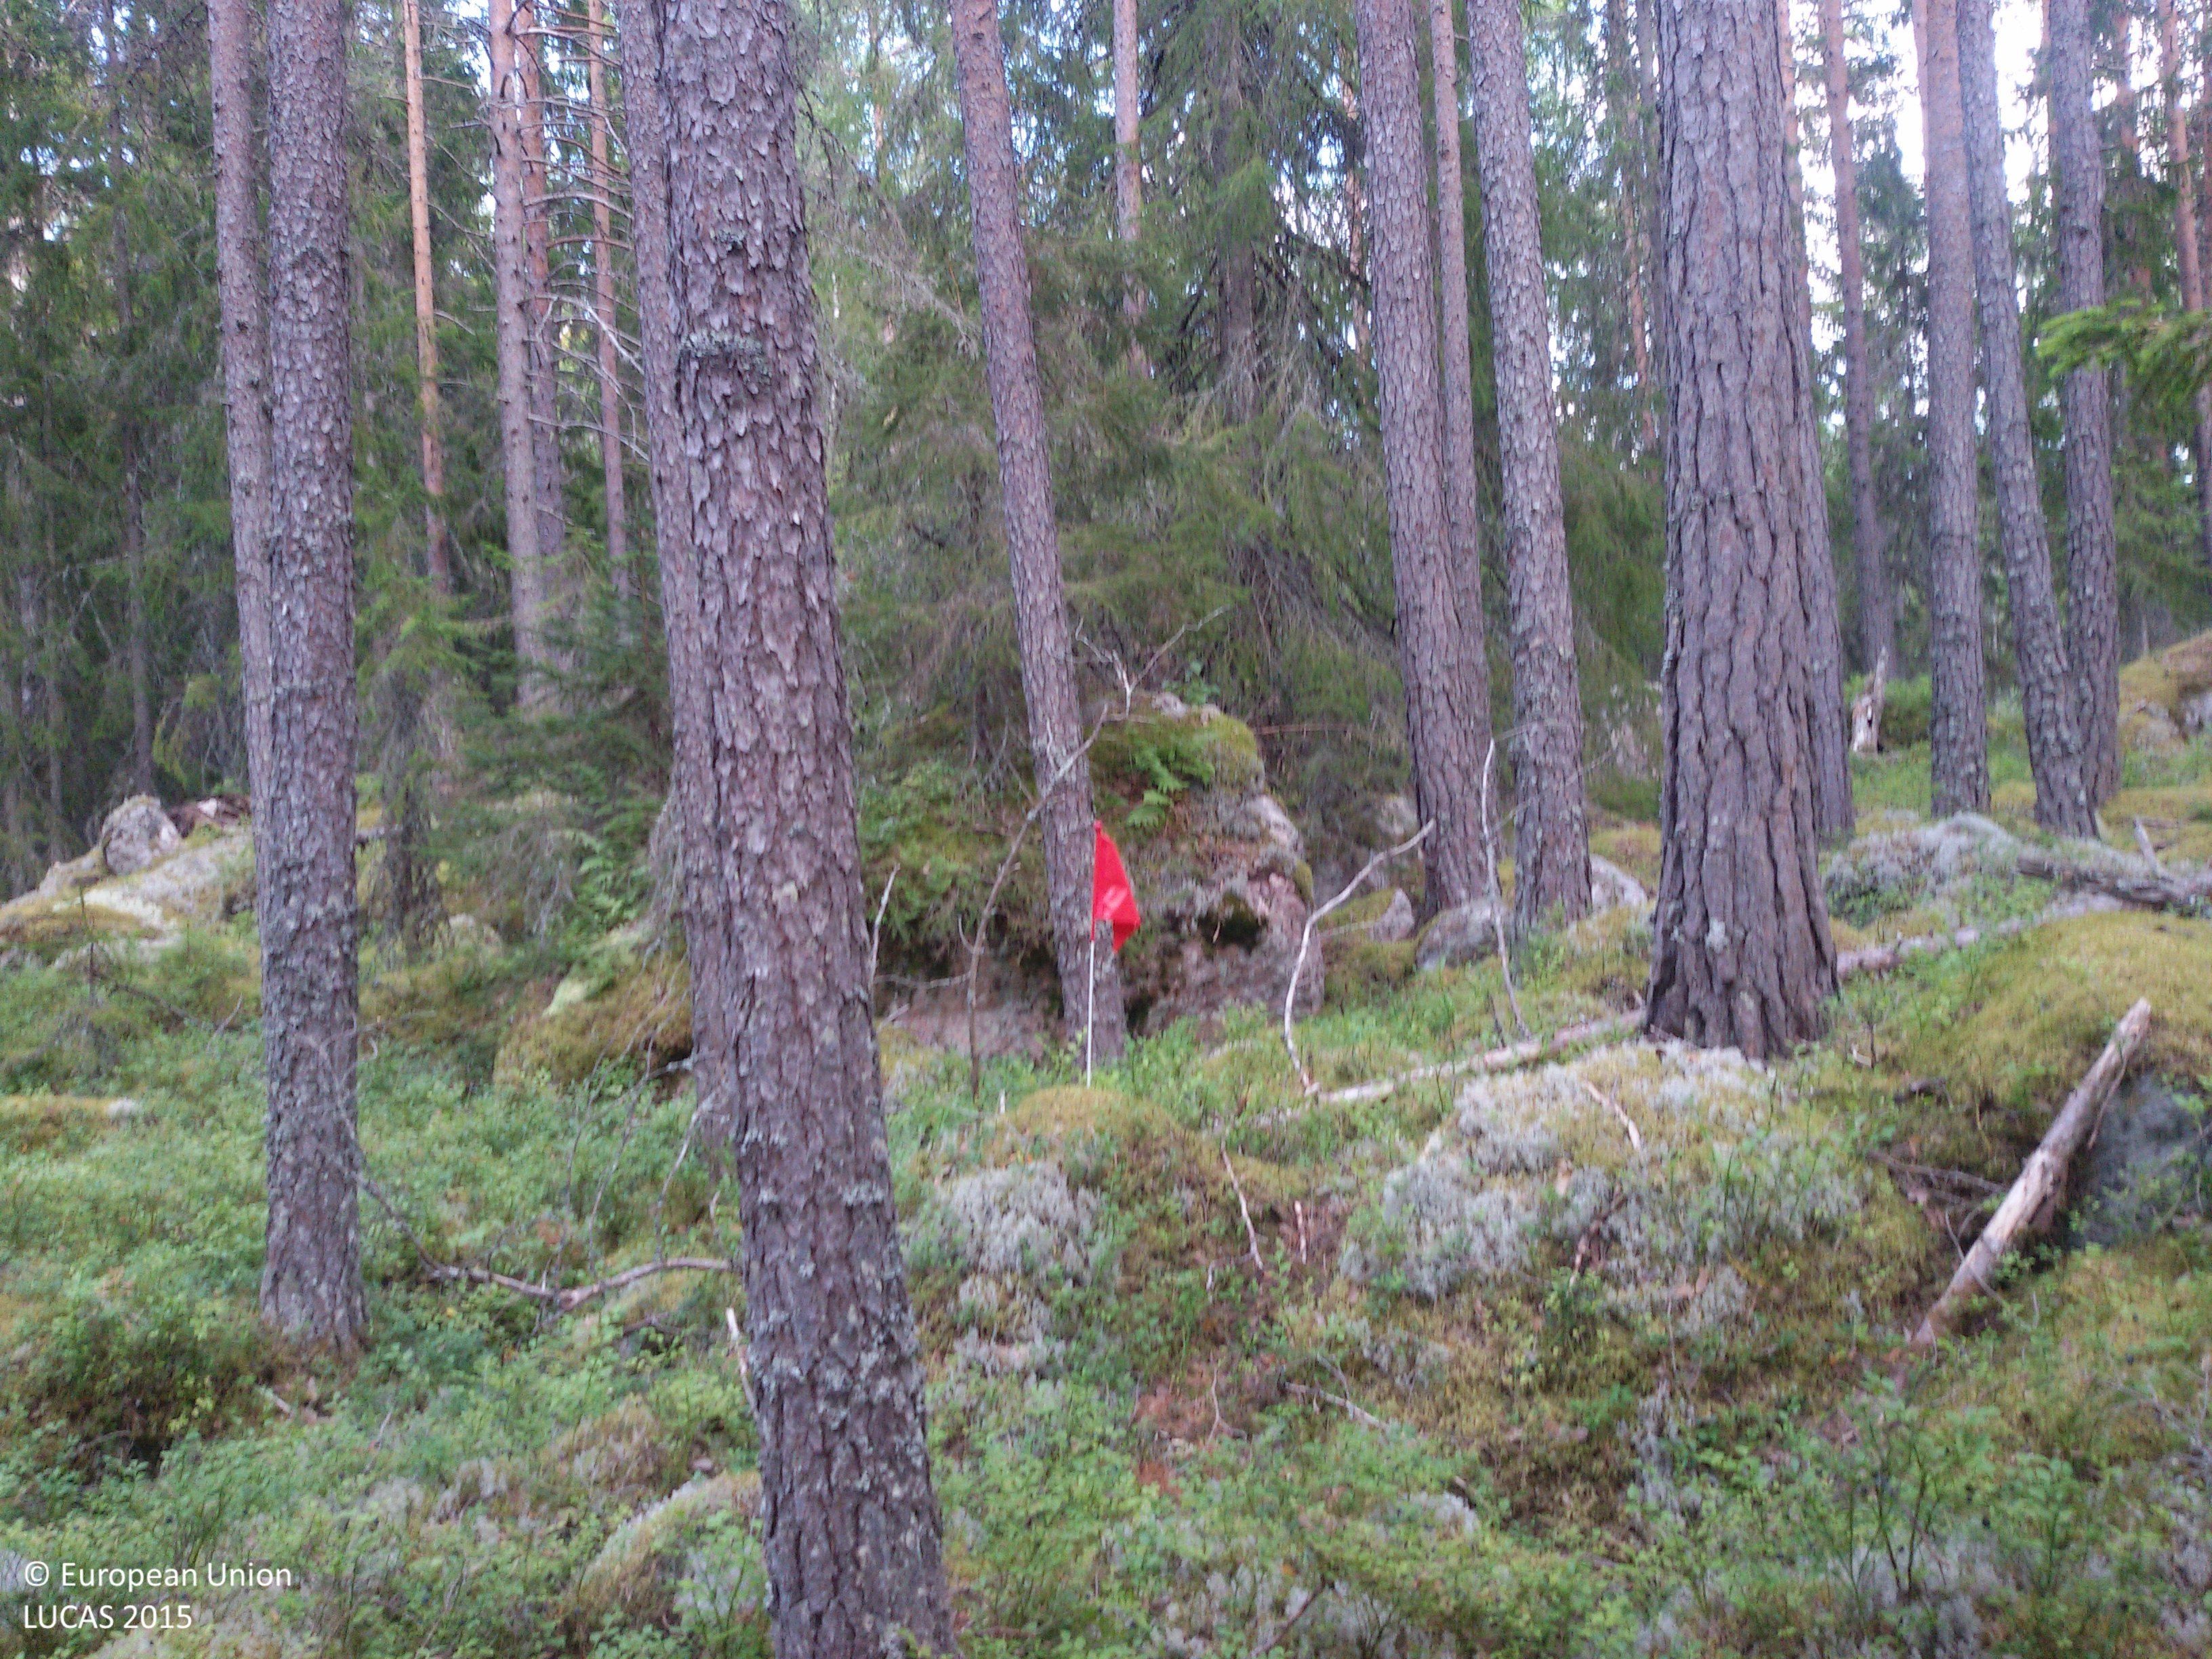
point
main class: Woodland
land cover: Pine dominated coniferous woodland
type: boreal forest
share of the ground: > 75 %
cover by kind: coniferous forest trees 80 %, shrubs 10 %, lichens and mosses 10 %
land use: Forestry
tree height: > 5 m
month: August
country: SE
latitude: 60.7160
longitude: 16.1269
